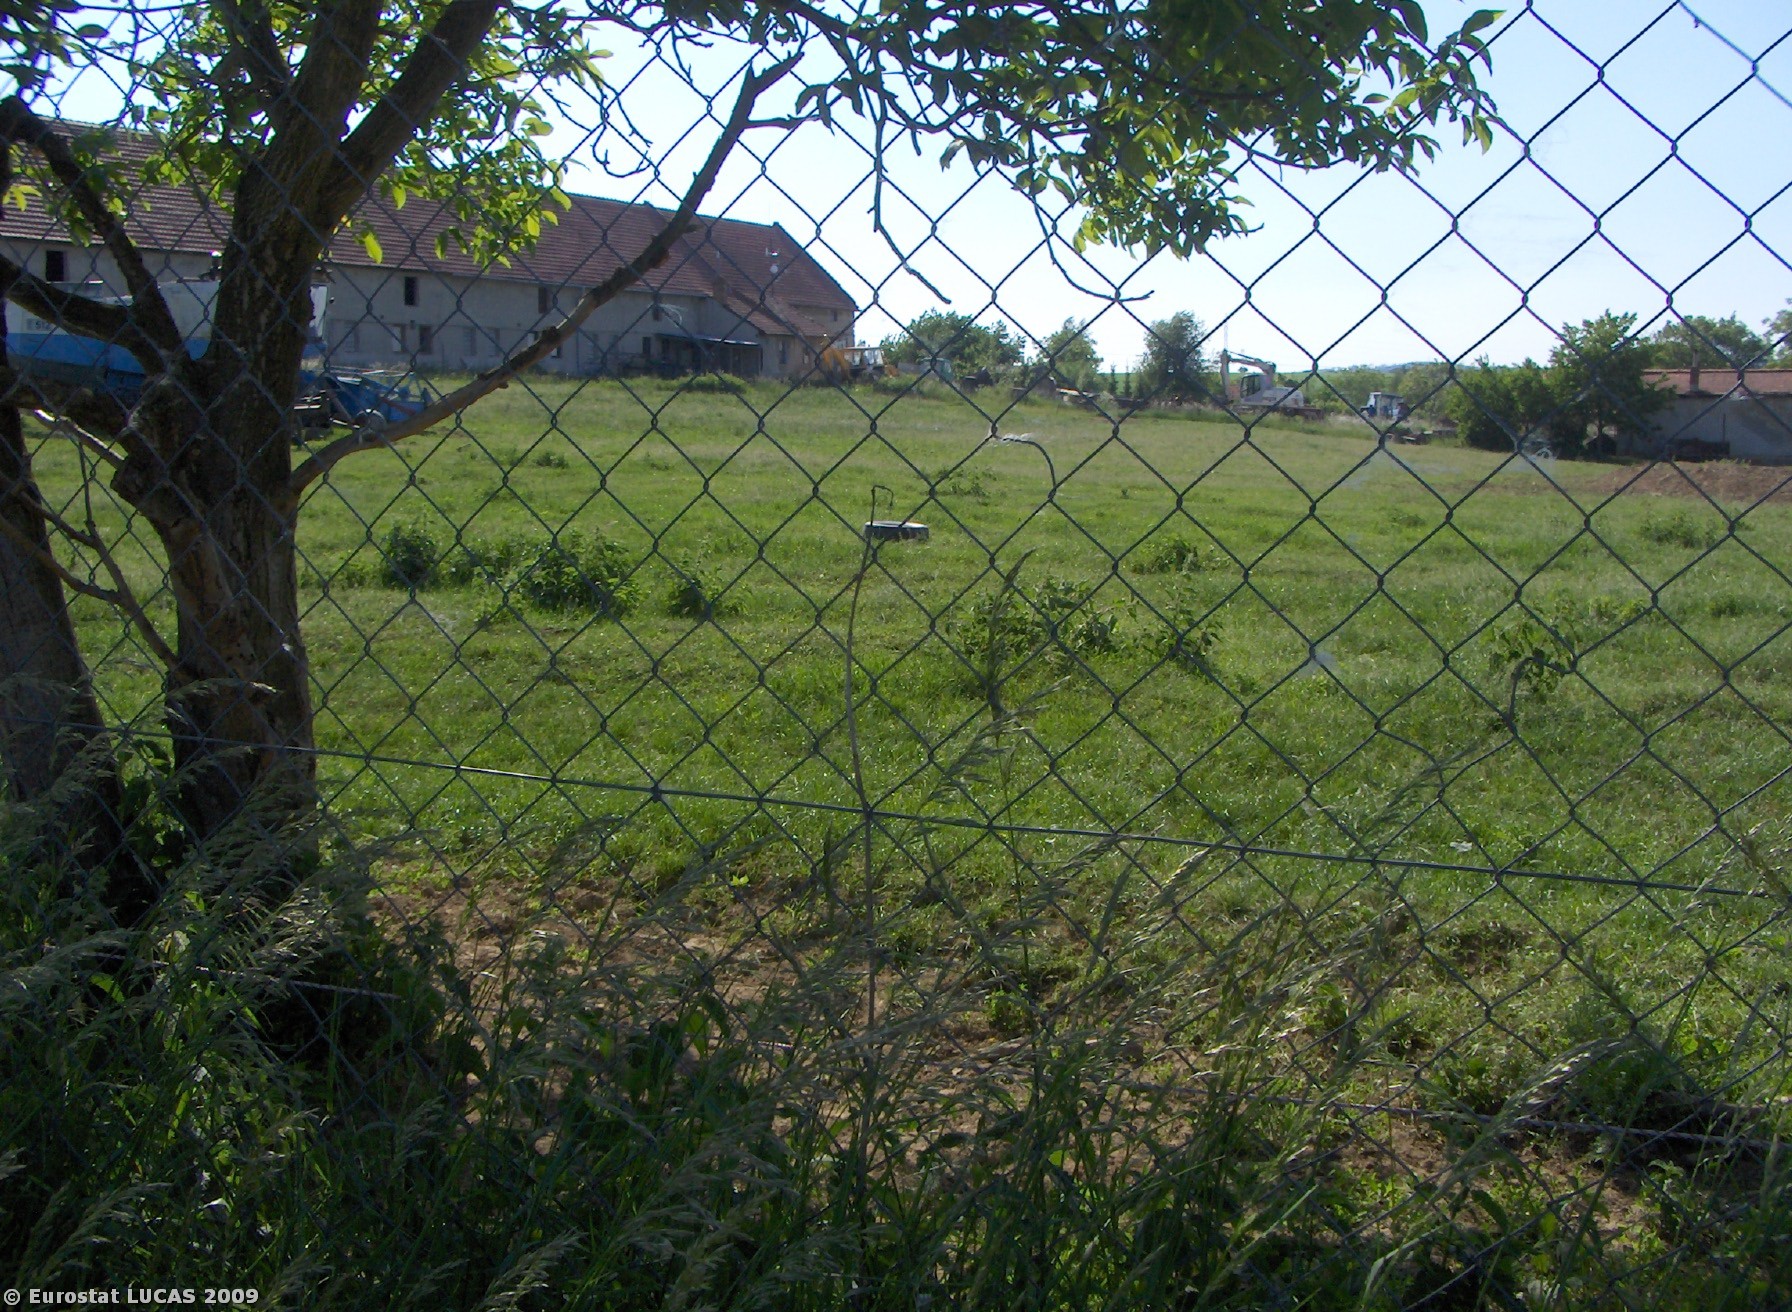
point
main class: Grassland
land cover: Grassland with sparse tree/shrub cover
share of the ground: > 75 %
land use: Agriculture (excluding fallow land and kitchen gardens)
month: May
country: CZ
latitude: 49.3848
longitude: 17.1042
